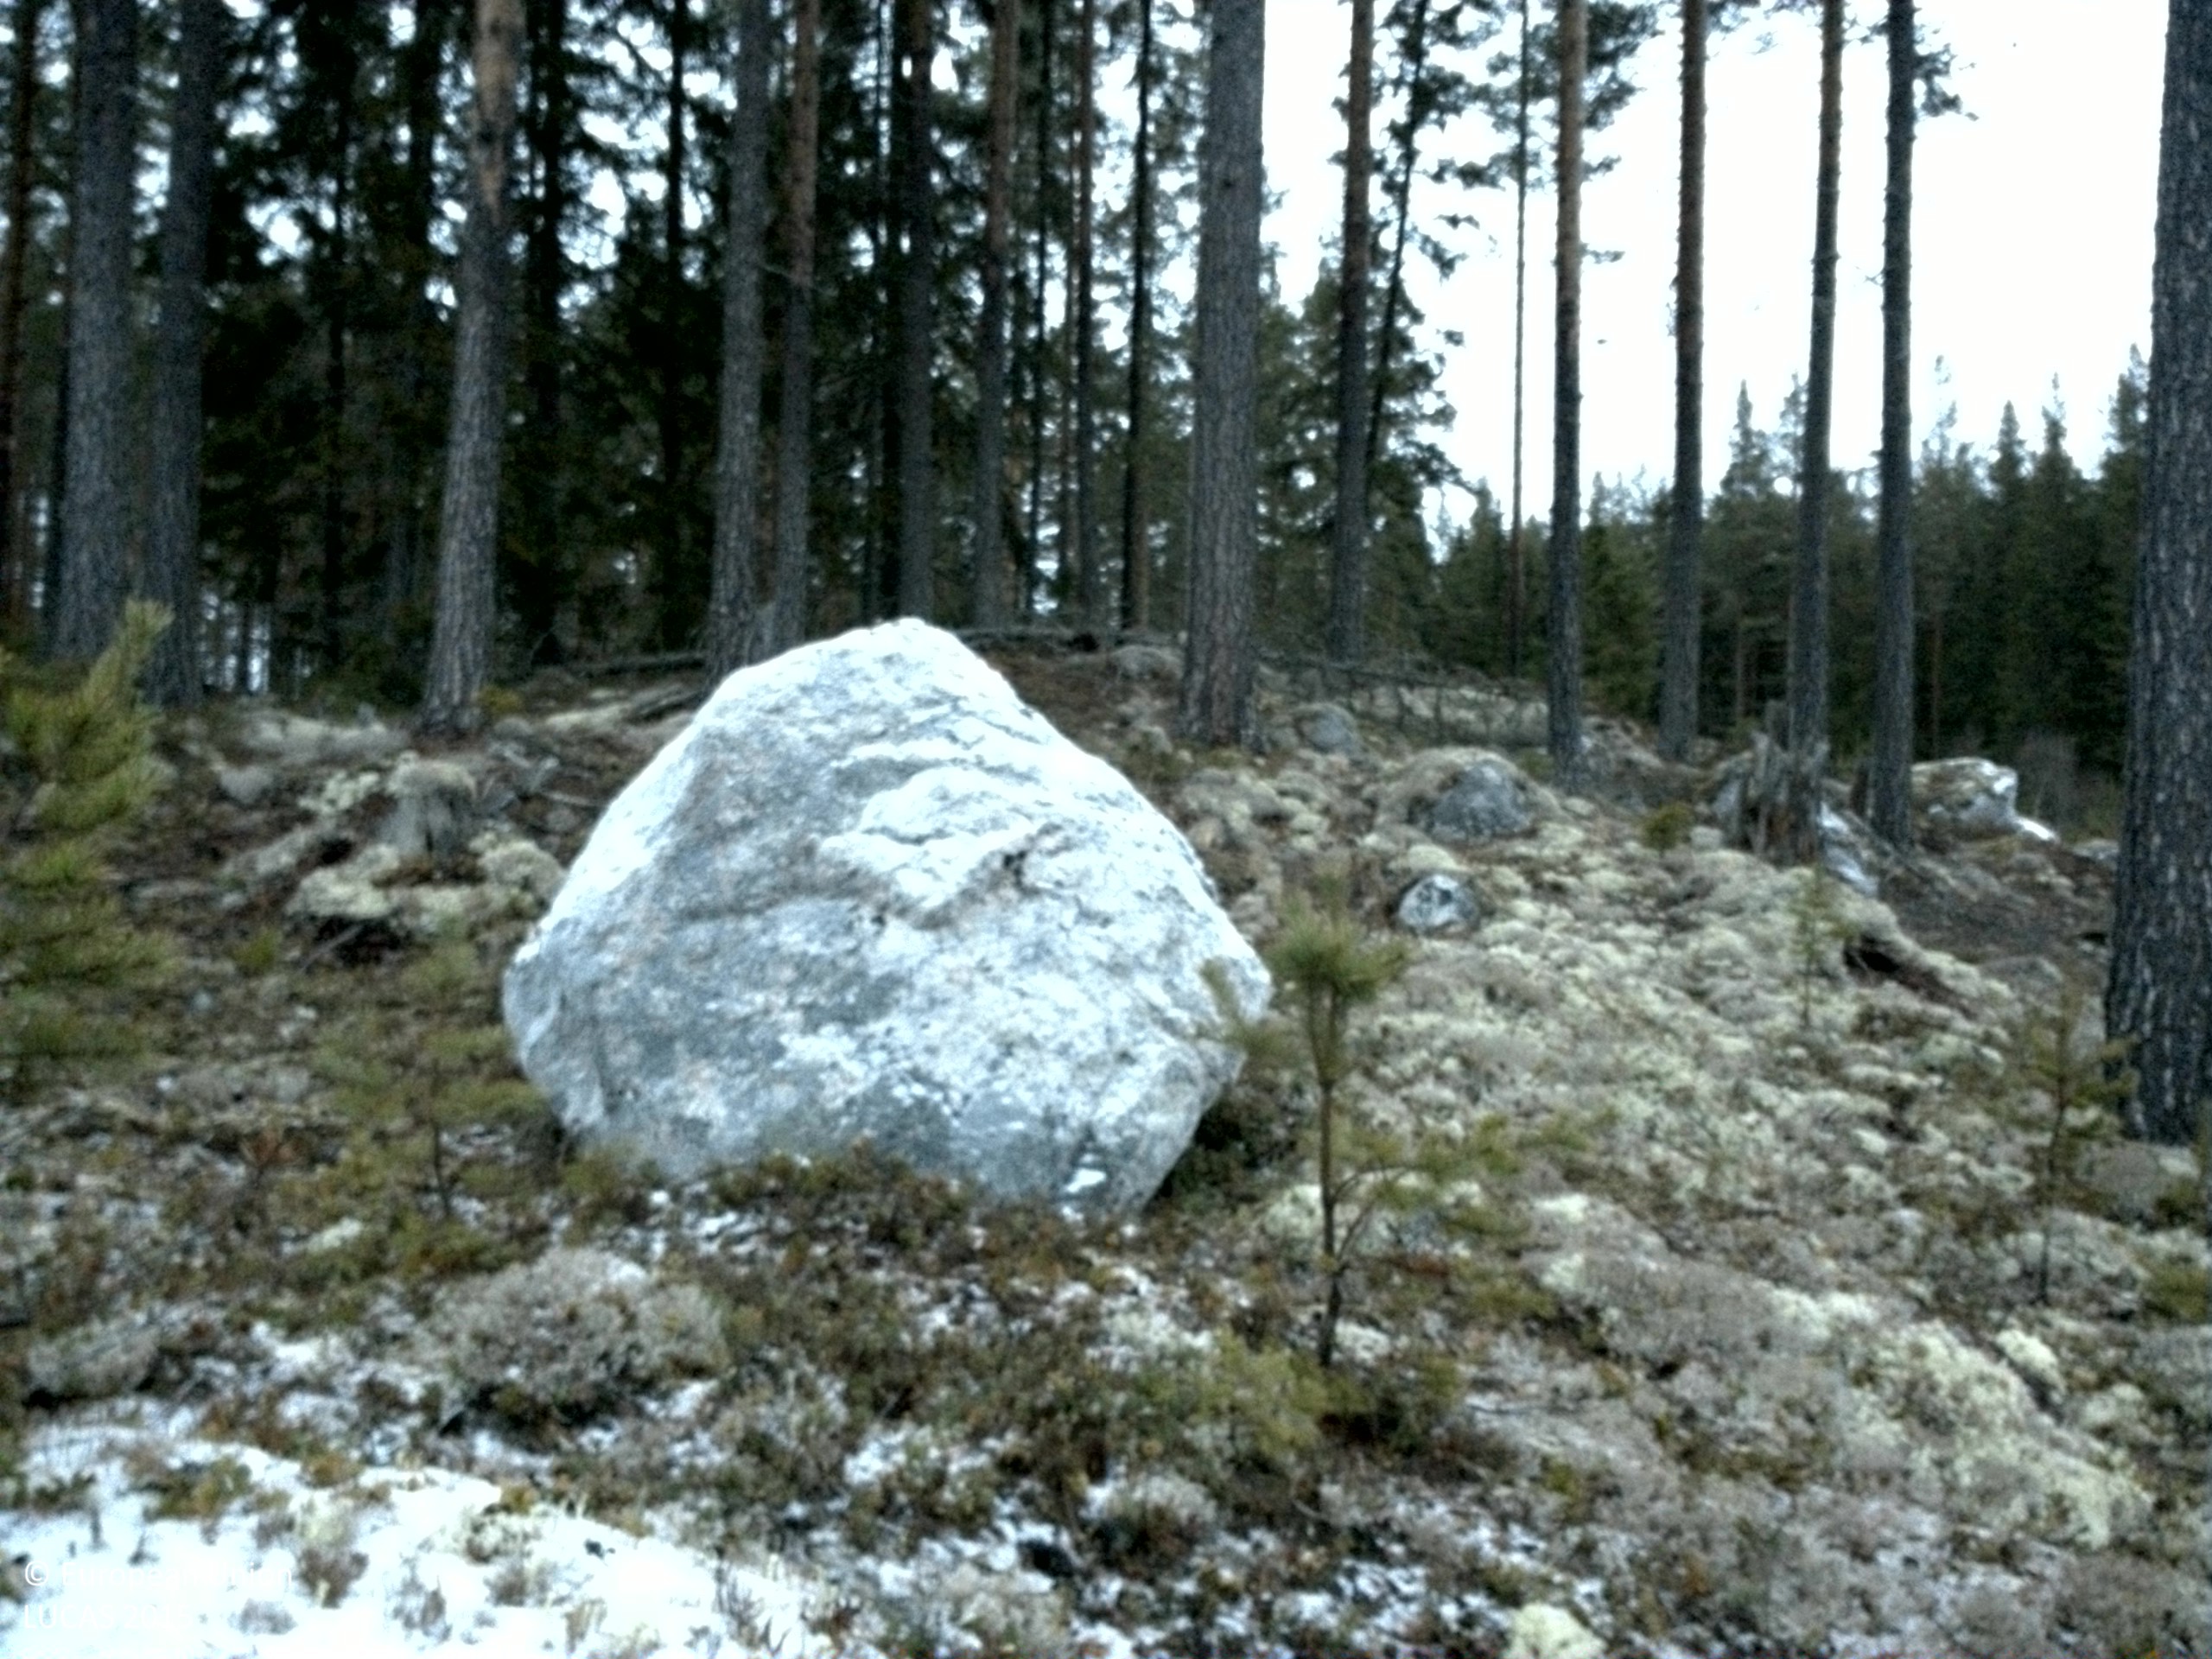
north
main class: Woodland
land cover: Pine dominated coniferous woodland
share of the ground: 10 - 25 %
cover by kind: shrubs 50 %, coniferous forest trees 20 %, lichens and mosses 20 %, consolidated bare surface 10 %
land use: Forestry
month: November
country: SE
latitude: 61.5225
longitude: 15.3796
